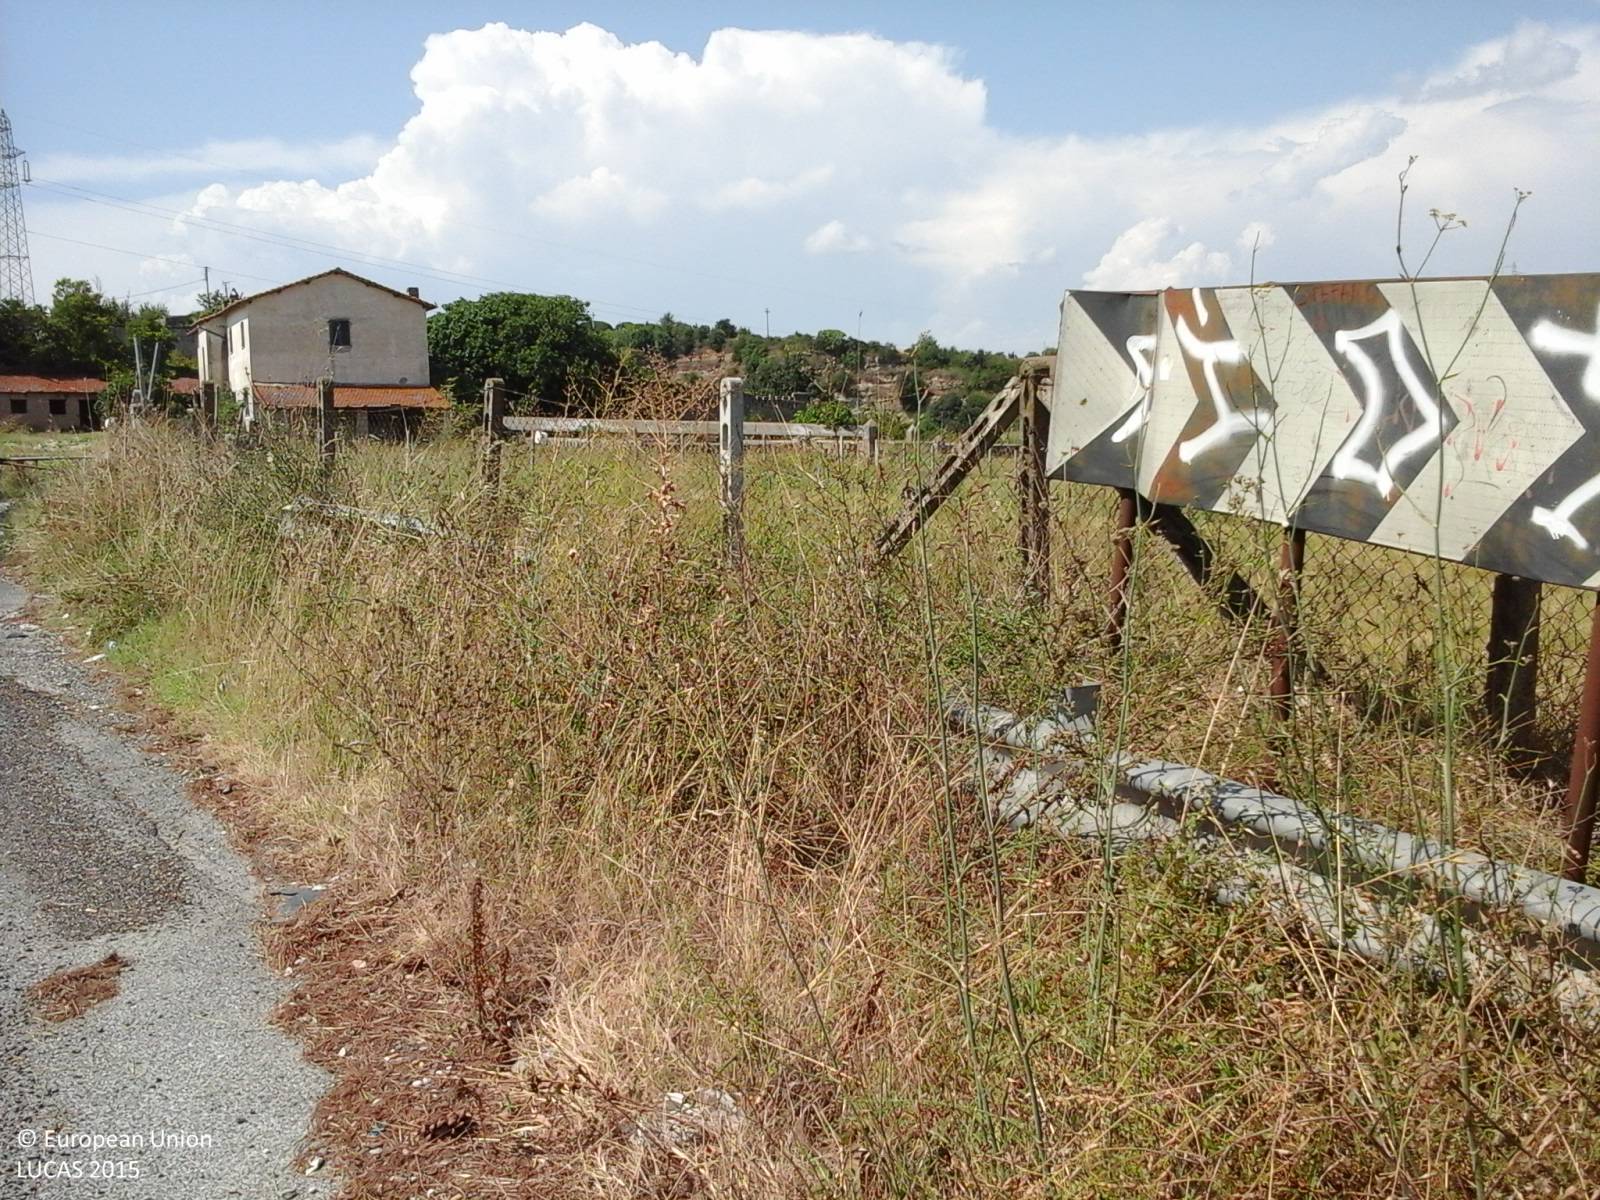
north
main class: Grassland
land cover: Grassland without tree/shrub cover
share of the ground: > 75 %
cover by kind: herbaceous plants 100 %
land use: Agriculture (excluding fallow land and kitchen gardens)
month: July
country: IT
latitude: 42.0974
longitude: 12.5663
